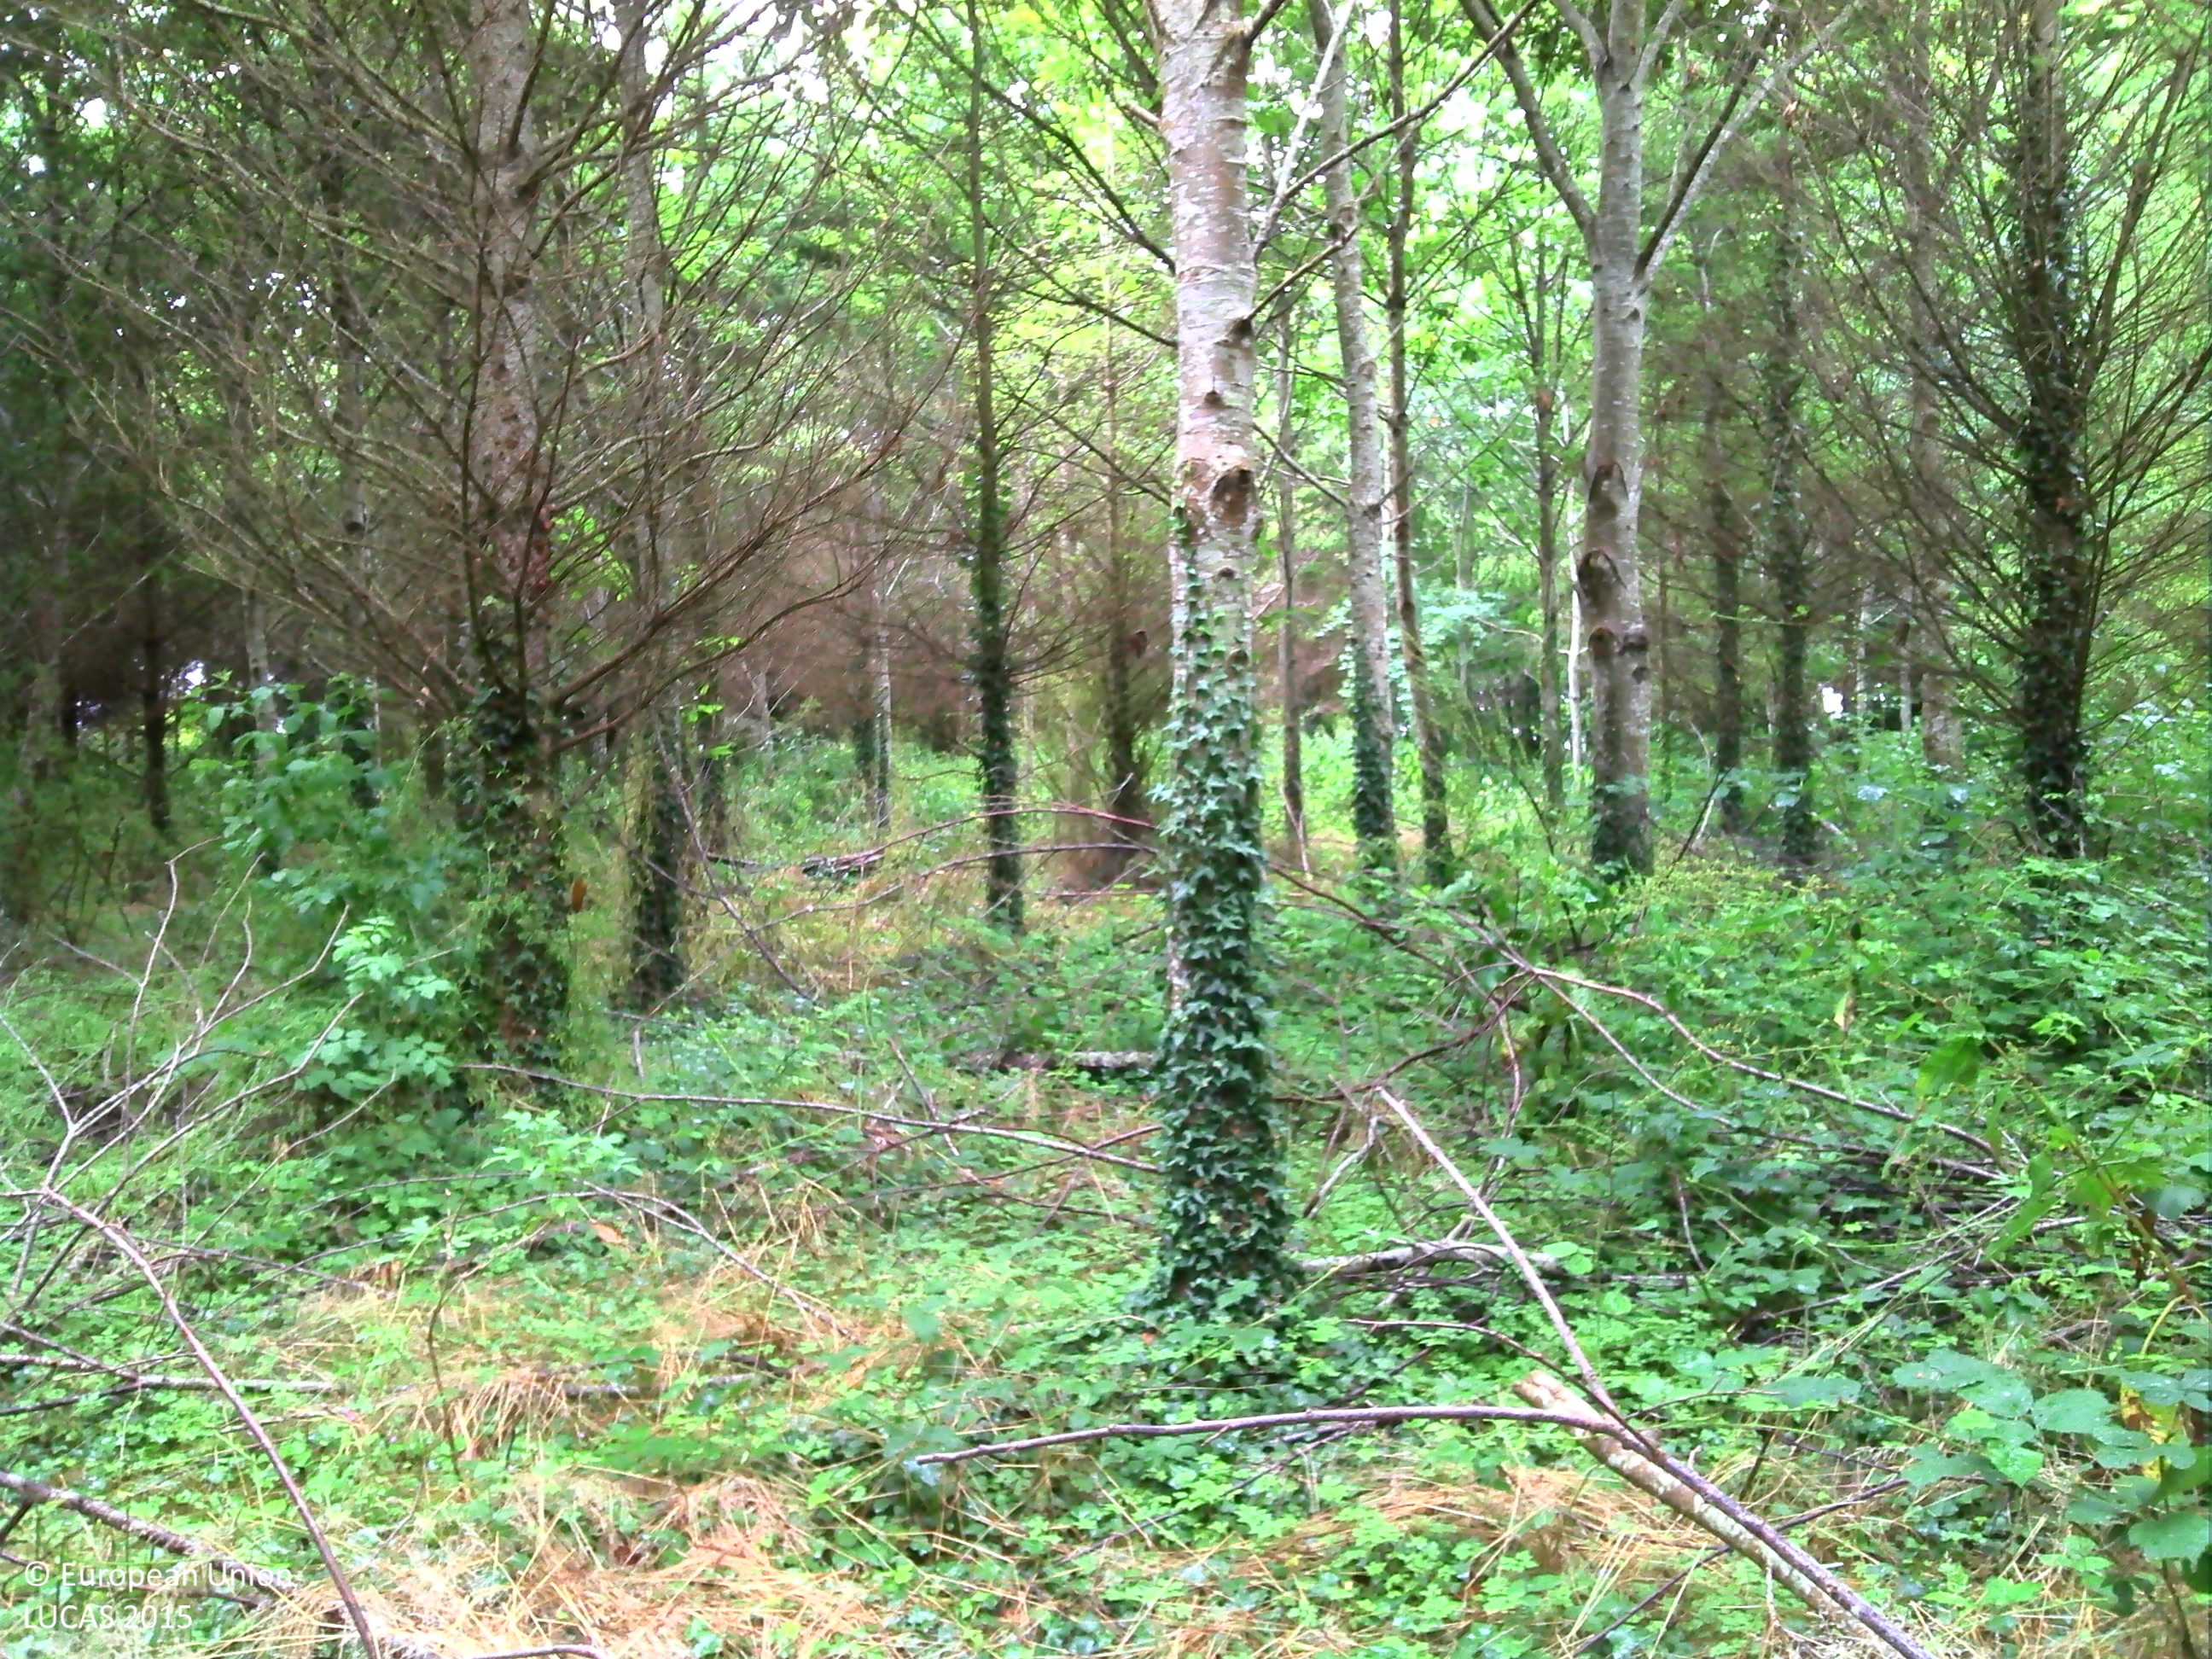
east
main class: Woodland
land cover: Spruce dominated mixed woodland
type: exotic forest
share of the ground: > 75 %
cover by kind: broadleaved forest trees 50 %, coniferous forest trees 25 %, shrubs 10 %, herbaceous plants 10 %, consolidated bare surface 5 %
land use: Forestry
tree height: > 5 m
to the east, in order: Spruce dominated mixed woodland; Spontaneously vegetated surfaces; Abandoned hedges; Grassland without tree/shrub cover; Dry stone walls; Broadleaved woodland; Barley
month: July
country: FR
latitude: 47.9961
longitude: -3.6007
